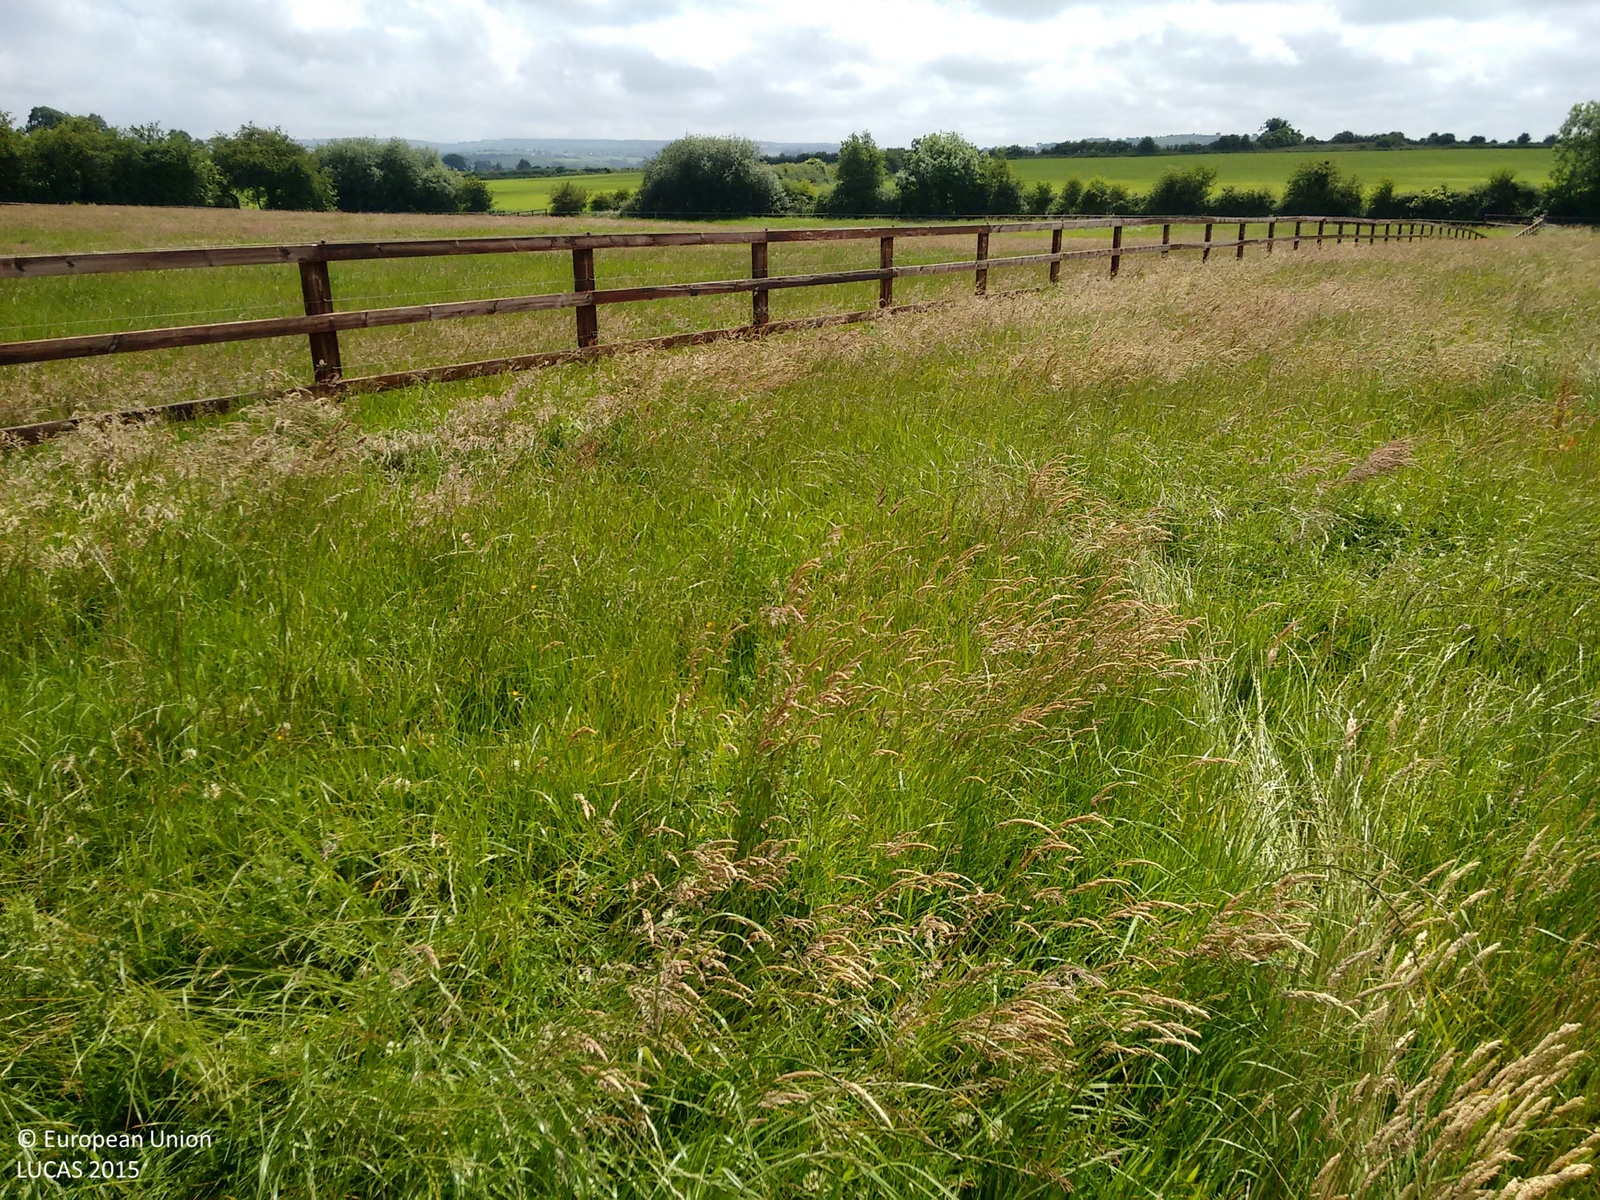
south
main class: Grassland
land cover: Grassland without tree/shrub cover
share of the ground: > 75 %
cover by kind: herbaceous plants 100 %
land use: Agriculture (excluding fallow land and kitchen gardens)
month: June
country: IE
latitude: 52.0999
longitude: -8.1824
